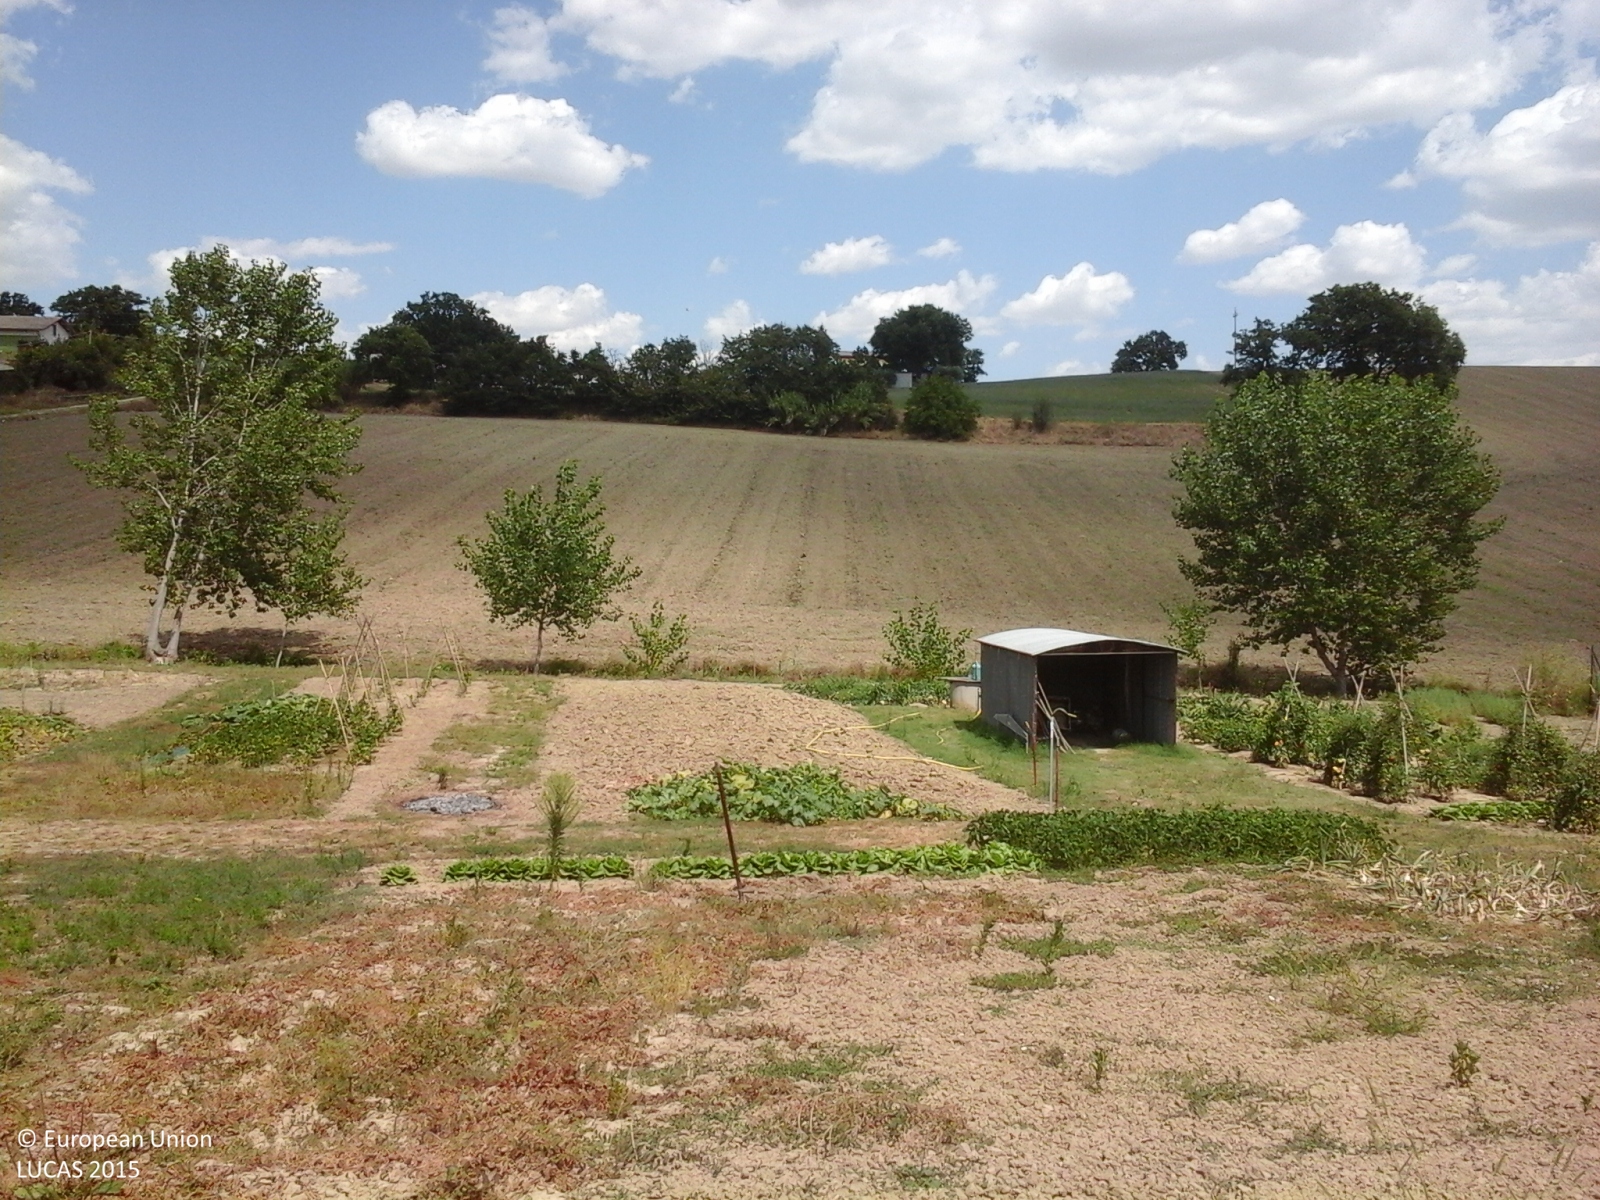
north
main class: Cropland
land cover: Olive groves
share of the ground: > 75 %
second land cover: Other bare soil
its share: > 75 %
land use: Agriculture (excluding fallow land and kitchen gardens)
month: July
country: IT
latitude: 43.3039
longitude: 13.3322
